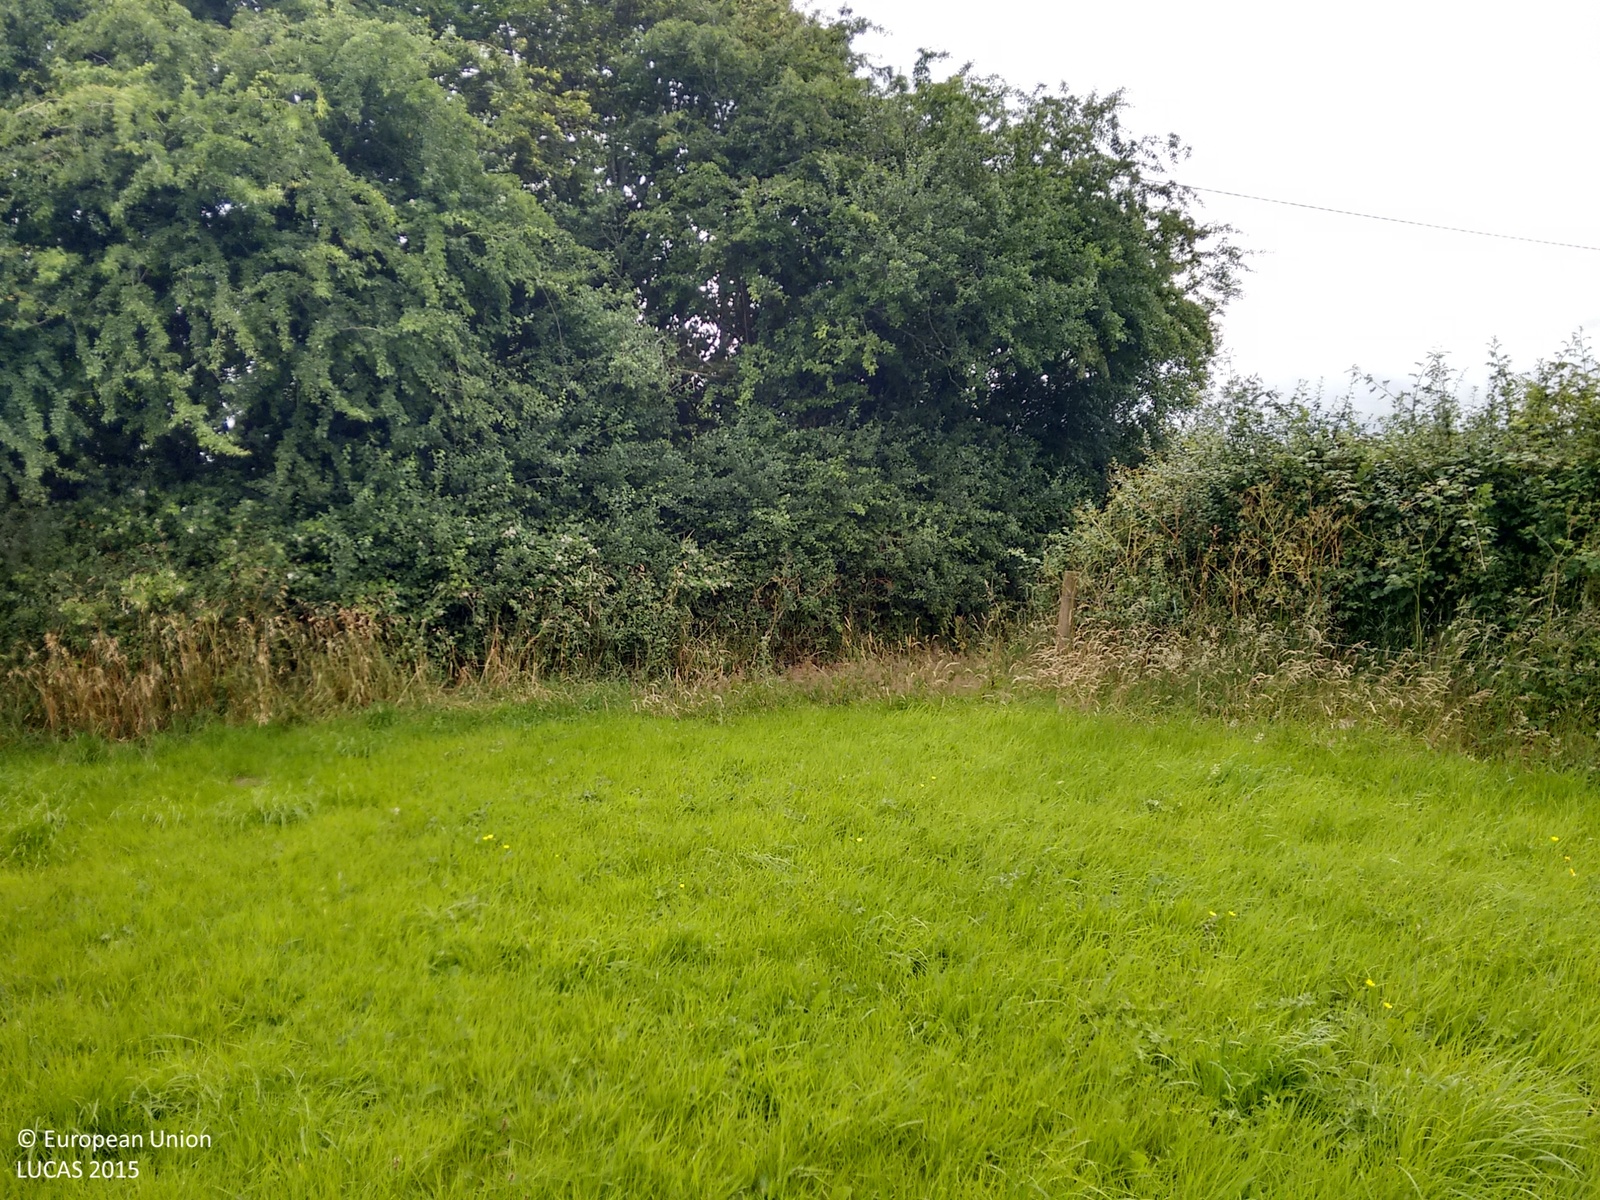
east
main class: Grassland
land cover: Grassland without tree/shrub cover
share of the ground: > 75 %
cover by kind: herbaceous plants 100 %
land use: Agriculture (excluding fallow land and kitchen gardens)
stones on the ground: < 10 %
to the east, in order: Grassland without tree/shrub cover; Fences; Abandoned hedges; Electric lines; Abandoned hedges; Managed hedges; Common wheat
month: July
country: IE
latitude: 52.5994
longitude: -7.3239
